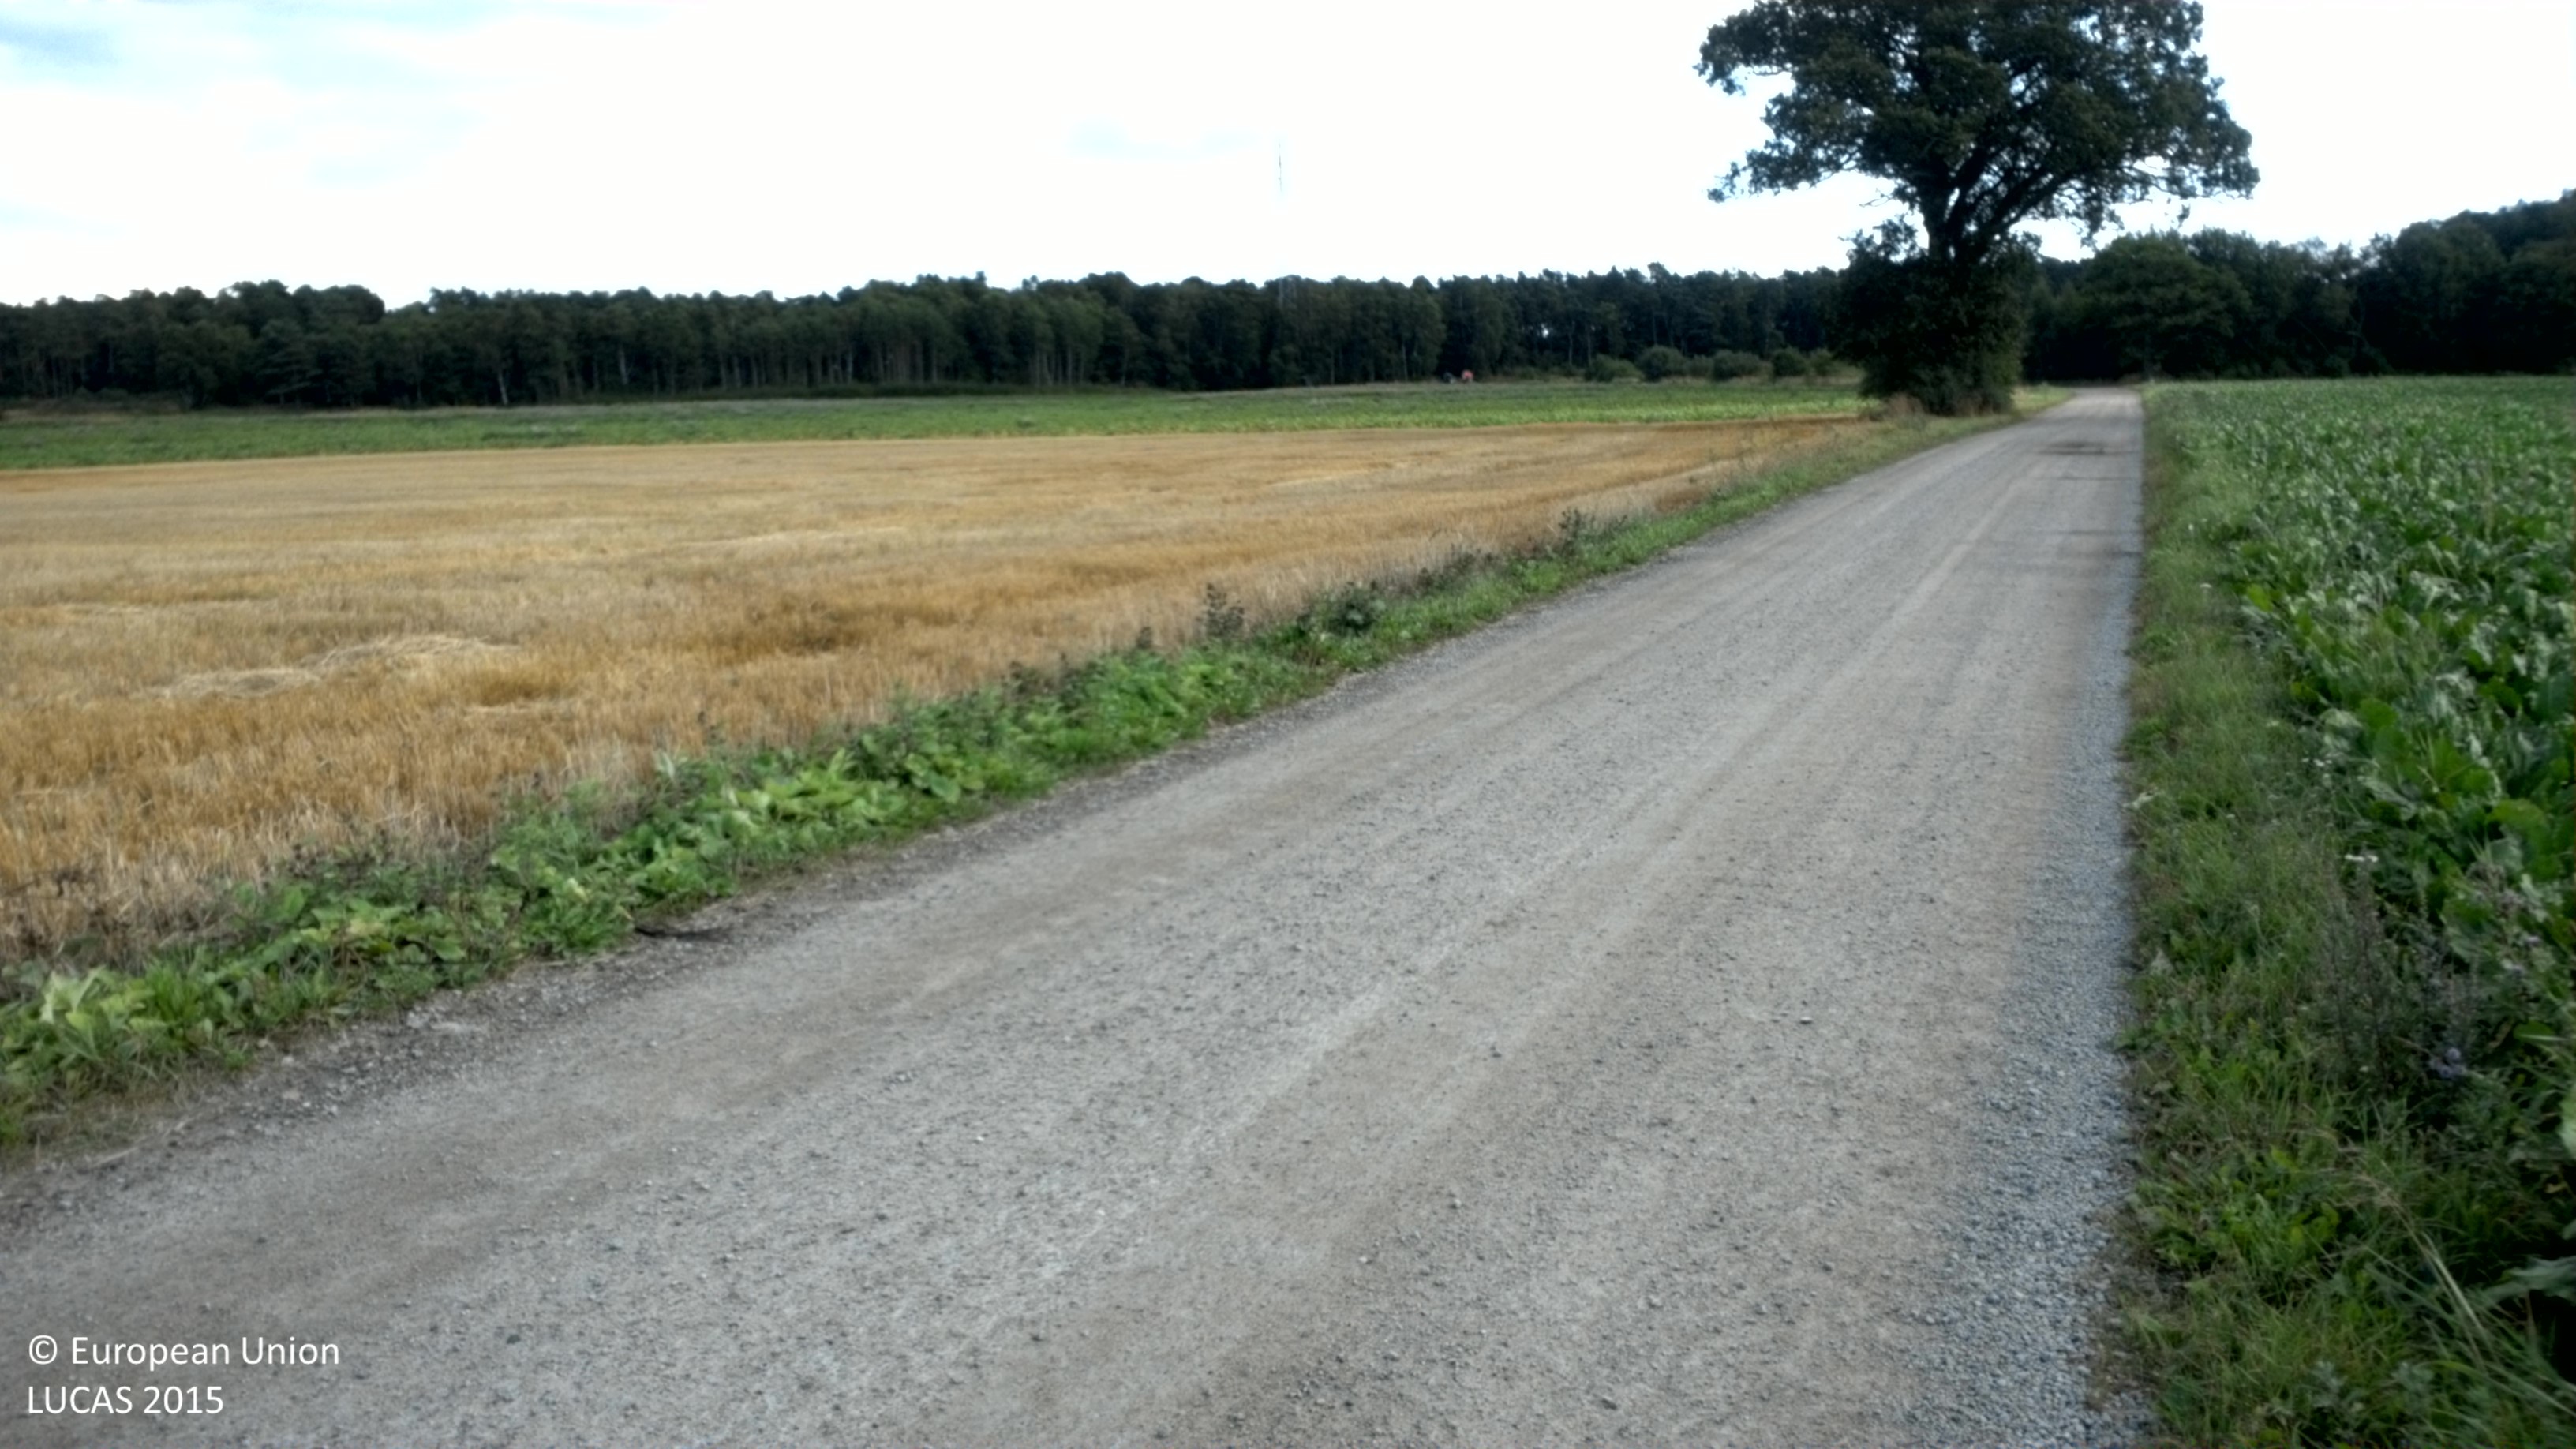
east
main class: Cropland
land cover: Sugar beet
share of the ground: > 75 %
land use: Agriculture (excluding fallow land and kitchen gardens)
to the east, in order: Sugar beet; Grass margins; Paved roads, cycling and walking lanes; Grass margins; Common wheat; Potatoes
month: September
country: SE
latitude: 56.1026
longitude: 14.6769
